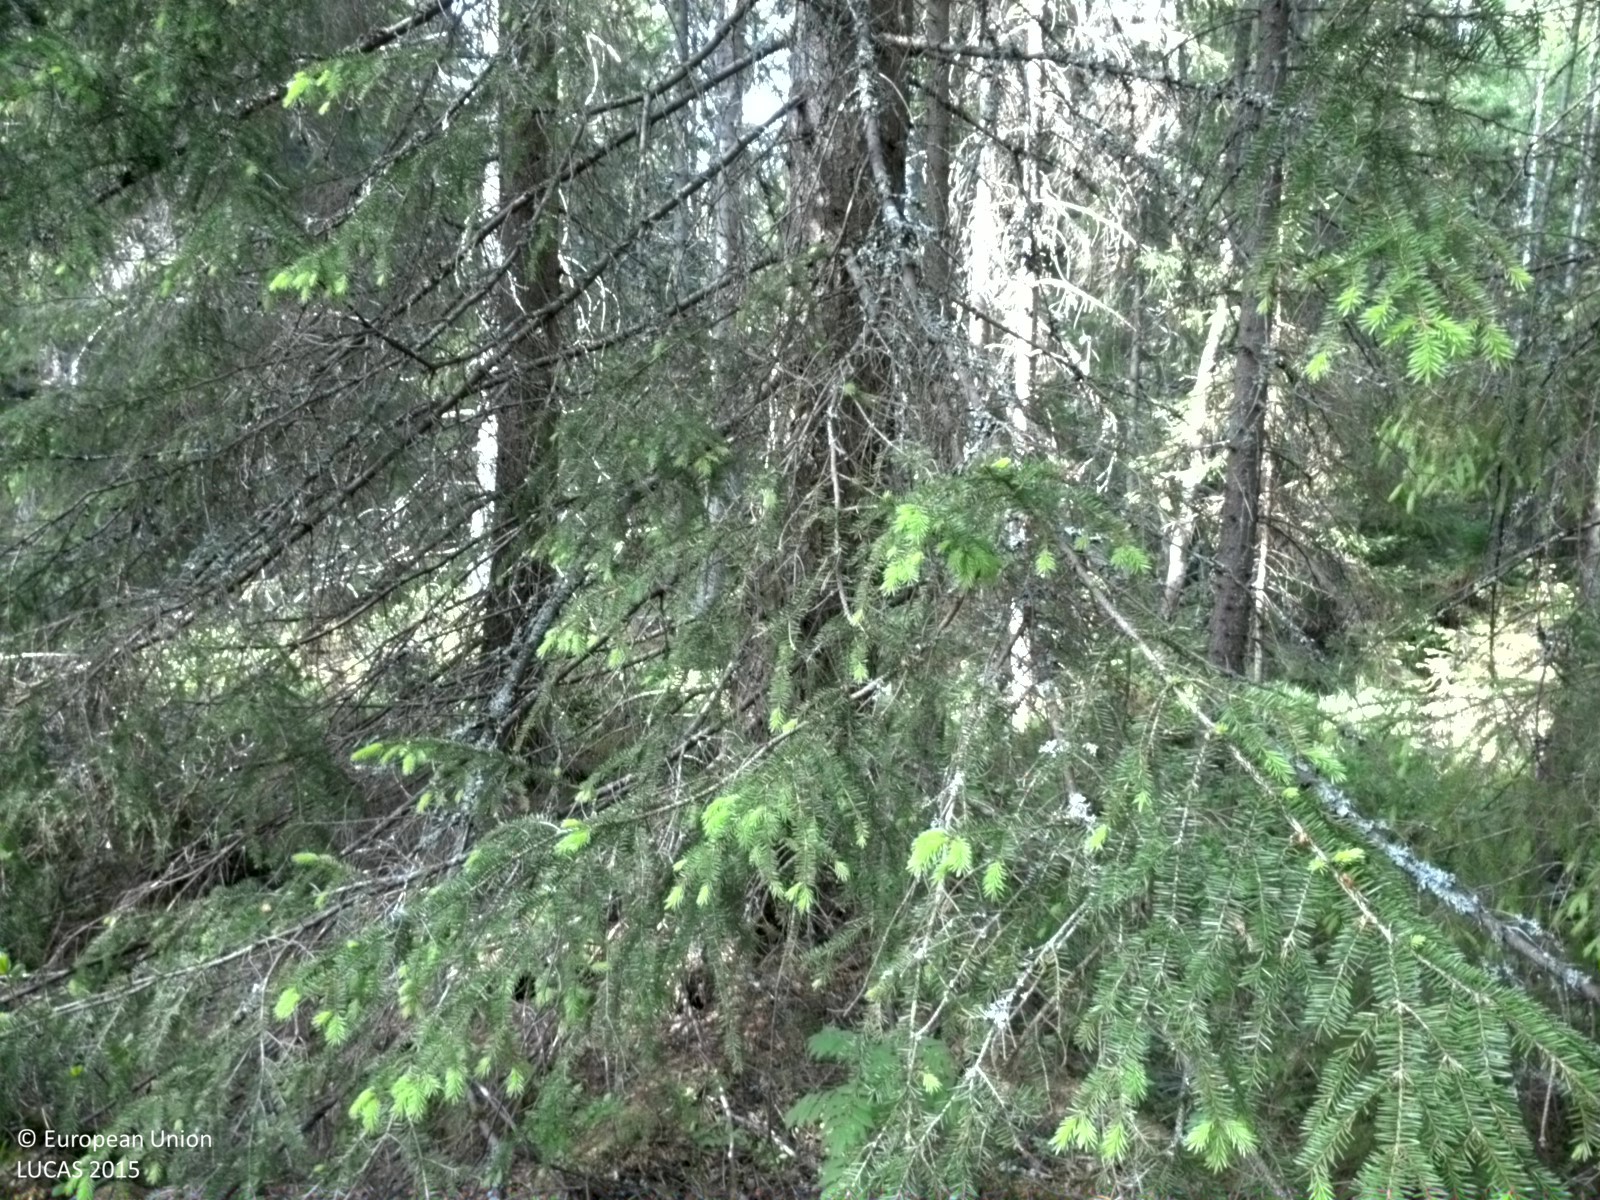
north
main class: Woodland
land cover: Spruce dominated coniferous woodland
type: boreal forest
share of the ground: > 75 %
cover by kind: coniferous forest trees 75 %, shrubs 10 %, broadleaved forest trees 5 %, herbaceous plants 5 %, lichens and mosses 5 %
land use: Forestry
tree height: > 5 m
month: June
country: SE
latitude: 60.2875
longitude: 17.1716
